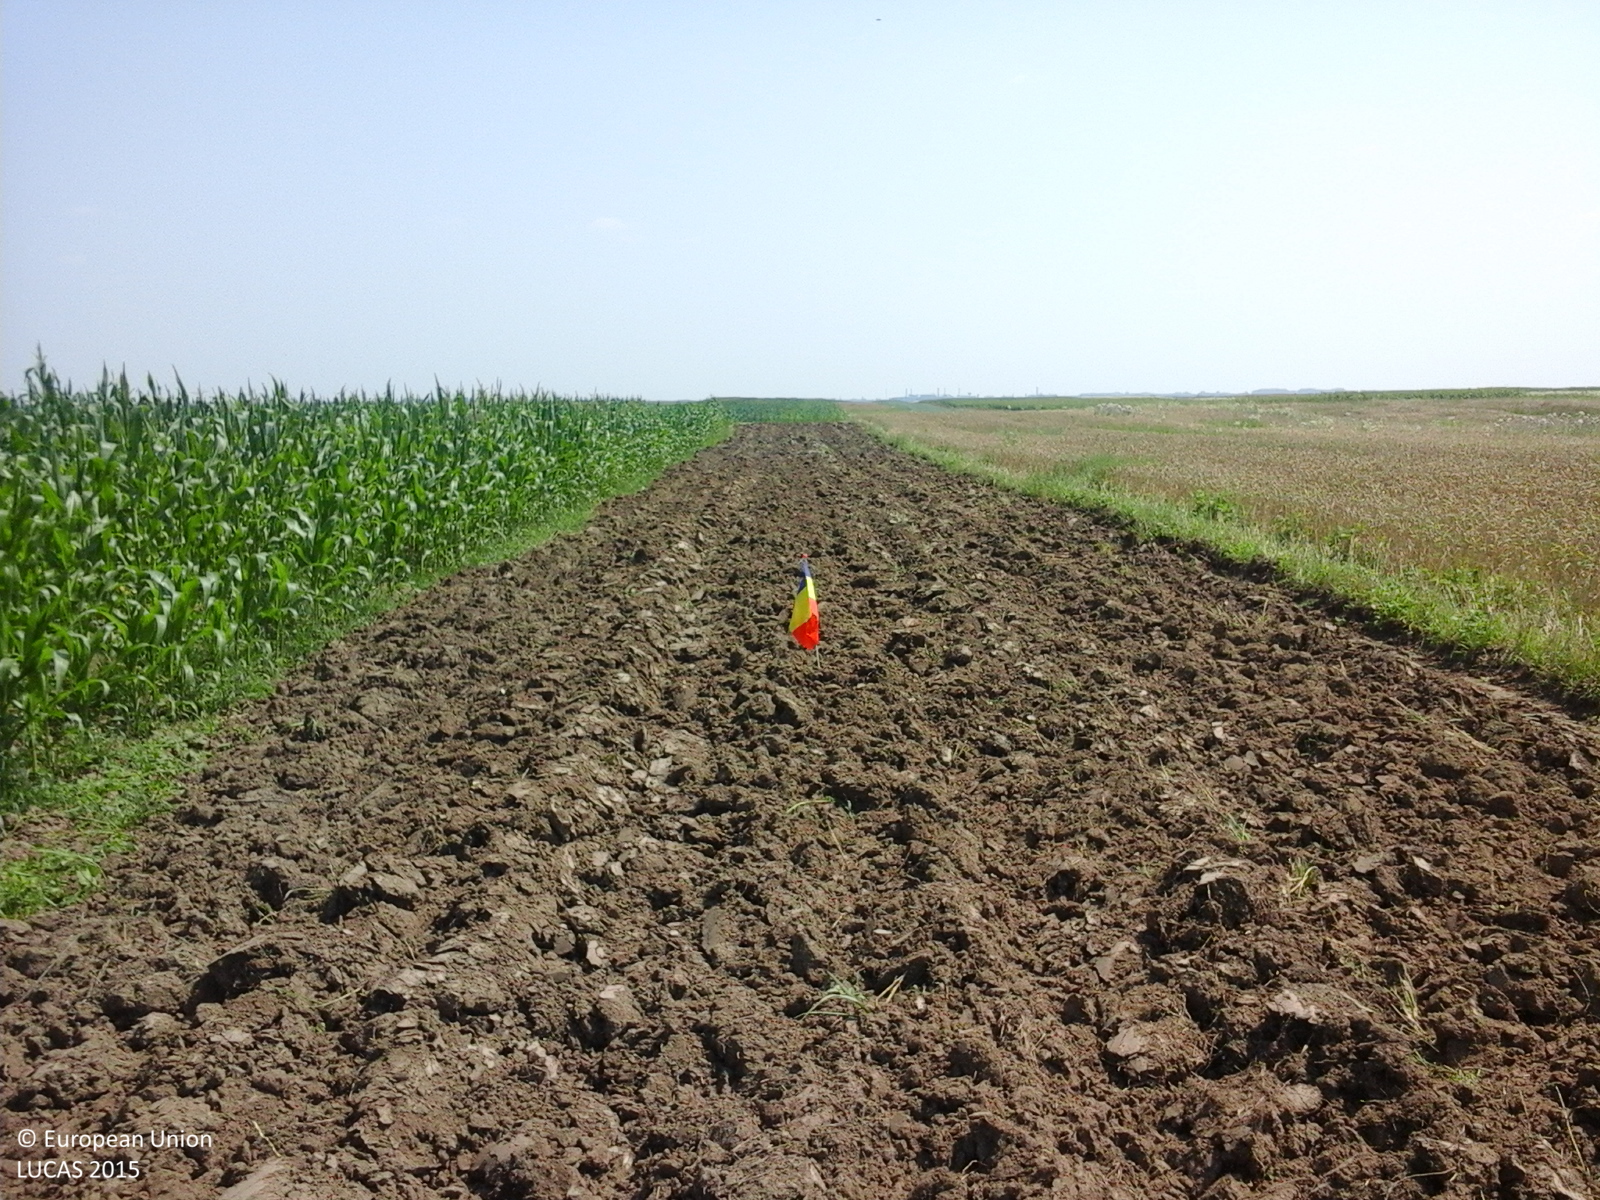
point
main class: Cropland
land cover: Barley
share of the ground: < 10 %
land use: Agriculture (excluding fallow land and kitchen gardens)
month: July
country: RO
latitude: 44.7305
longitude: 25.5374
